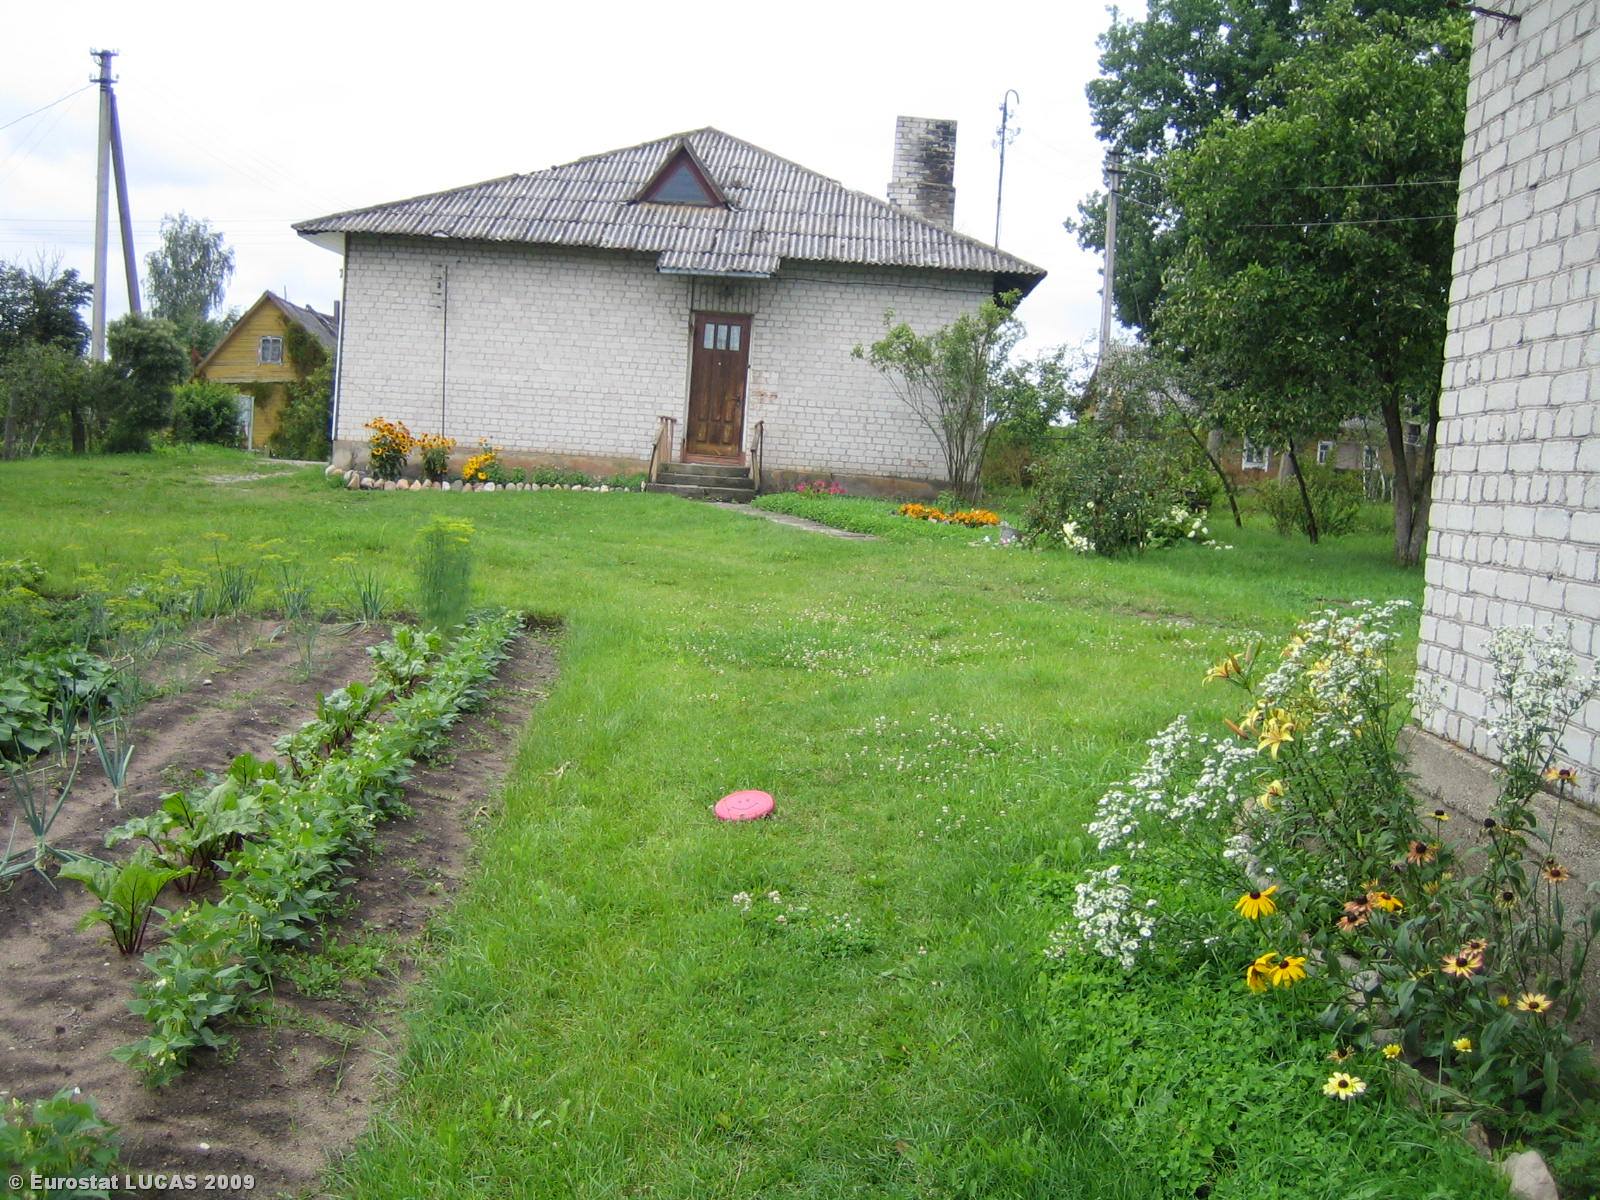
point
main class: Grassland
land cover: Grassland without tree/shrub cover
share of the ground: > 75 %
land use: Residential
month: July
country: LT
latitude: 55.5863
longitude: 25.4976
